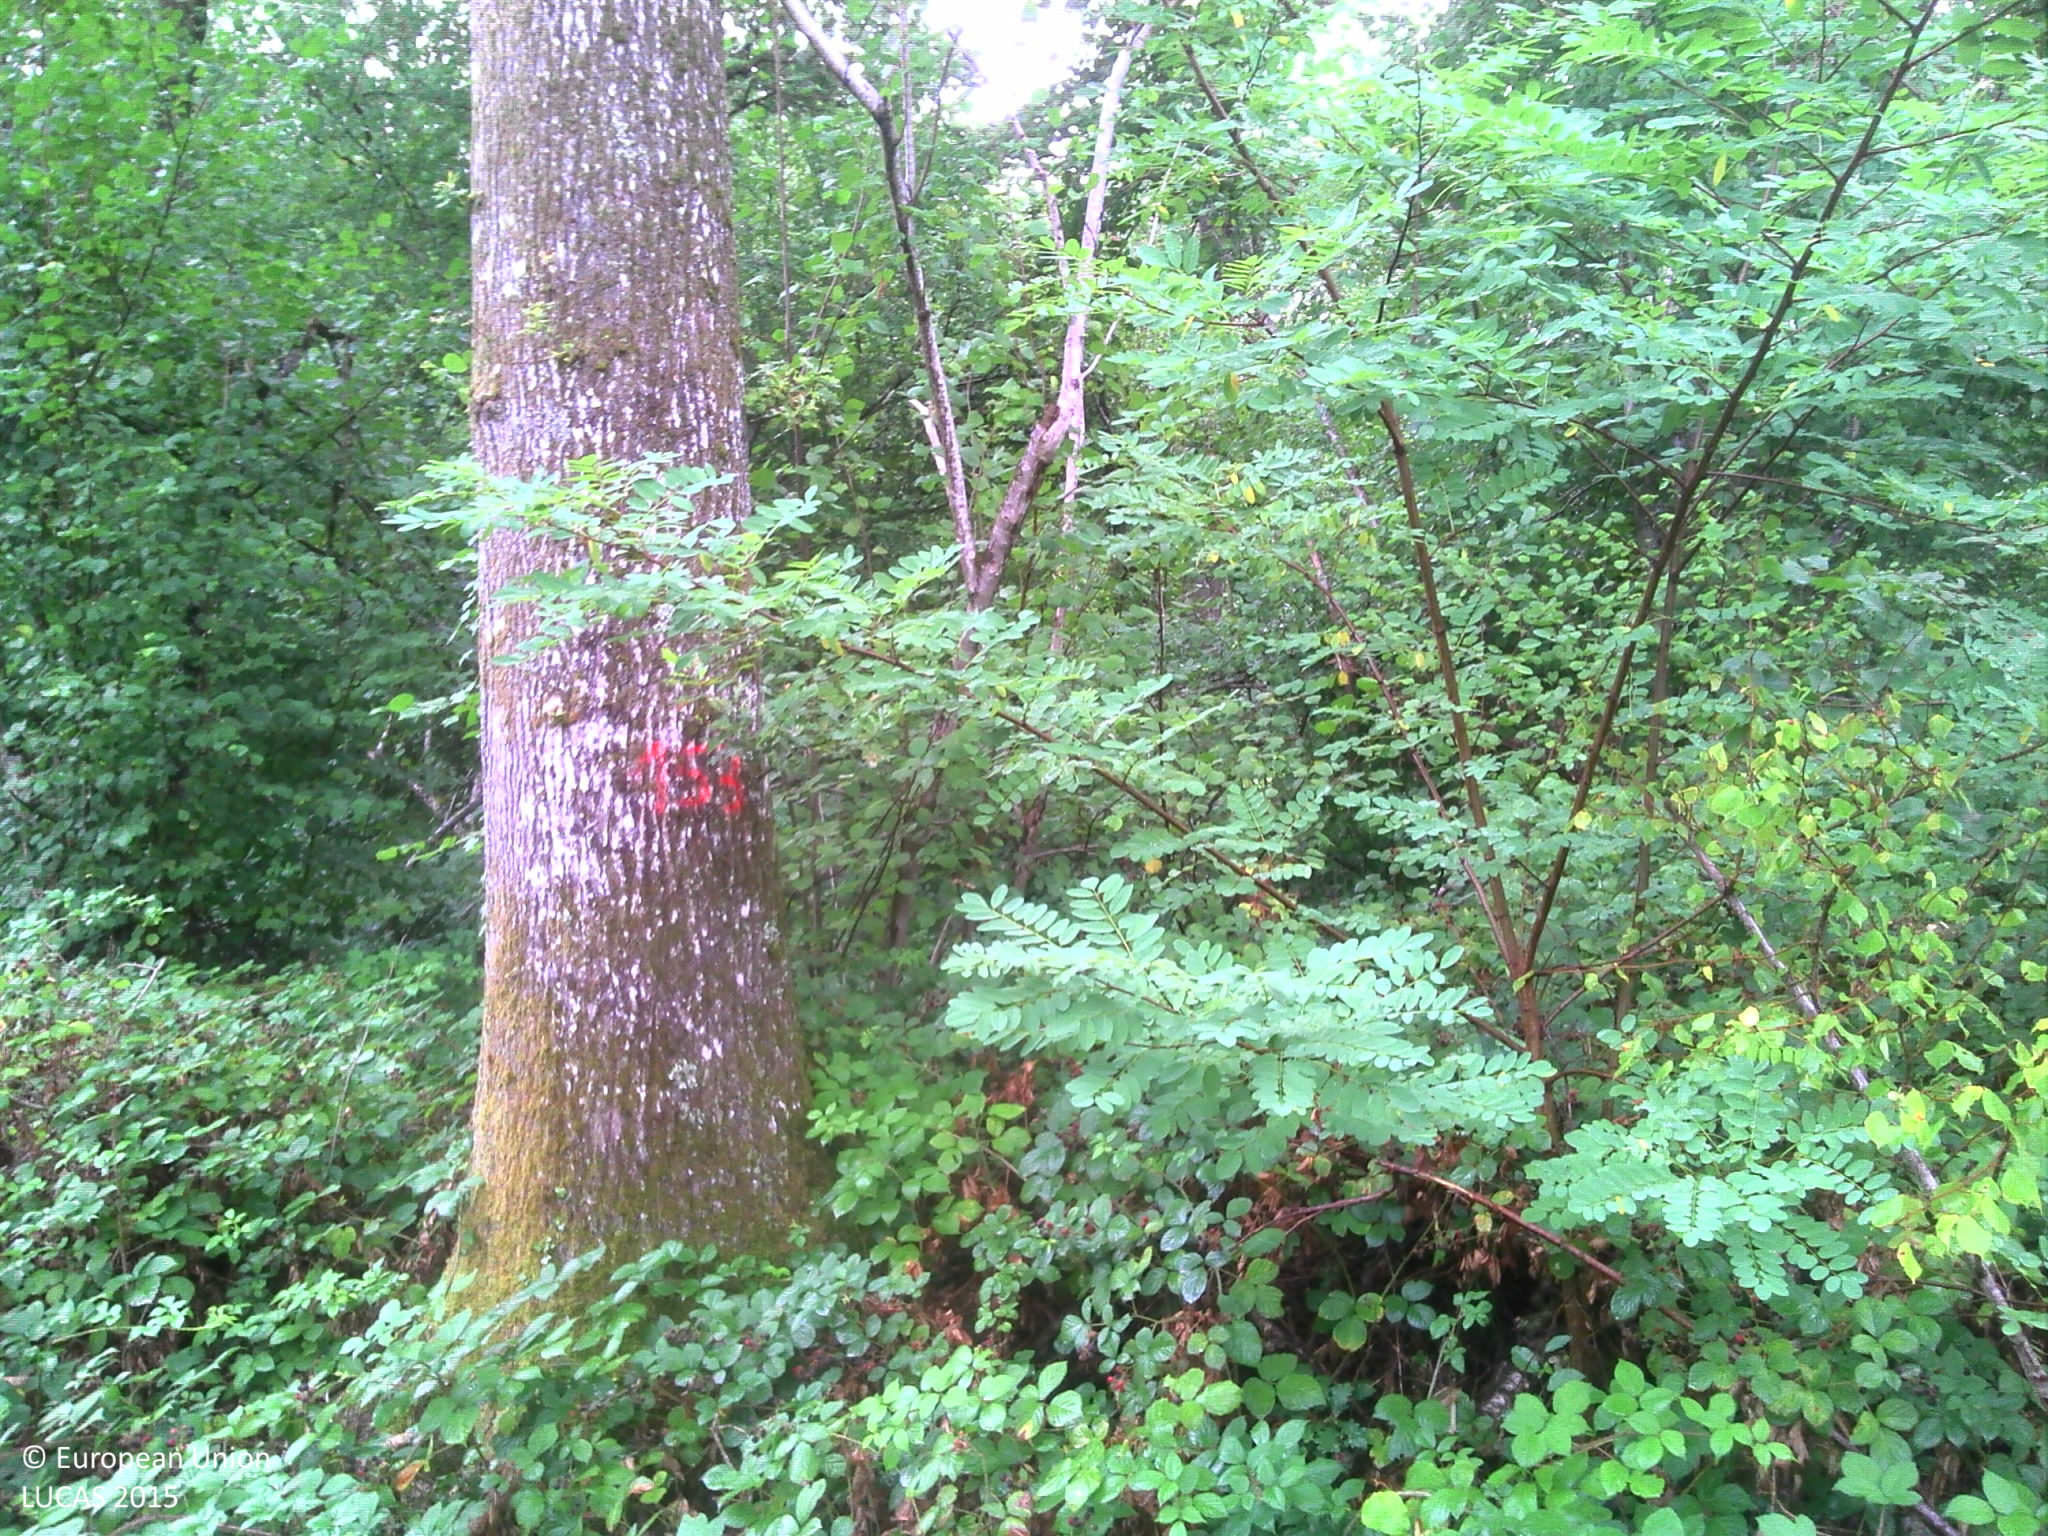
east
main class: Woodland
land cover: Broadleaved woodland
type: mesophytic deciduous forest
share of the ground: > 75 %
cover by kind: broadleaved forest trees 75 %, herbaceous plants 25 %
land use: Forestry
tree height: > 5 m
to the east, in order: Broadleaved woodland; Grass margins; Inland fresh water bodies
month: July
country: FR
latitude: 46.6899
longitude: 5.0984
